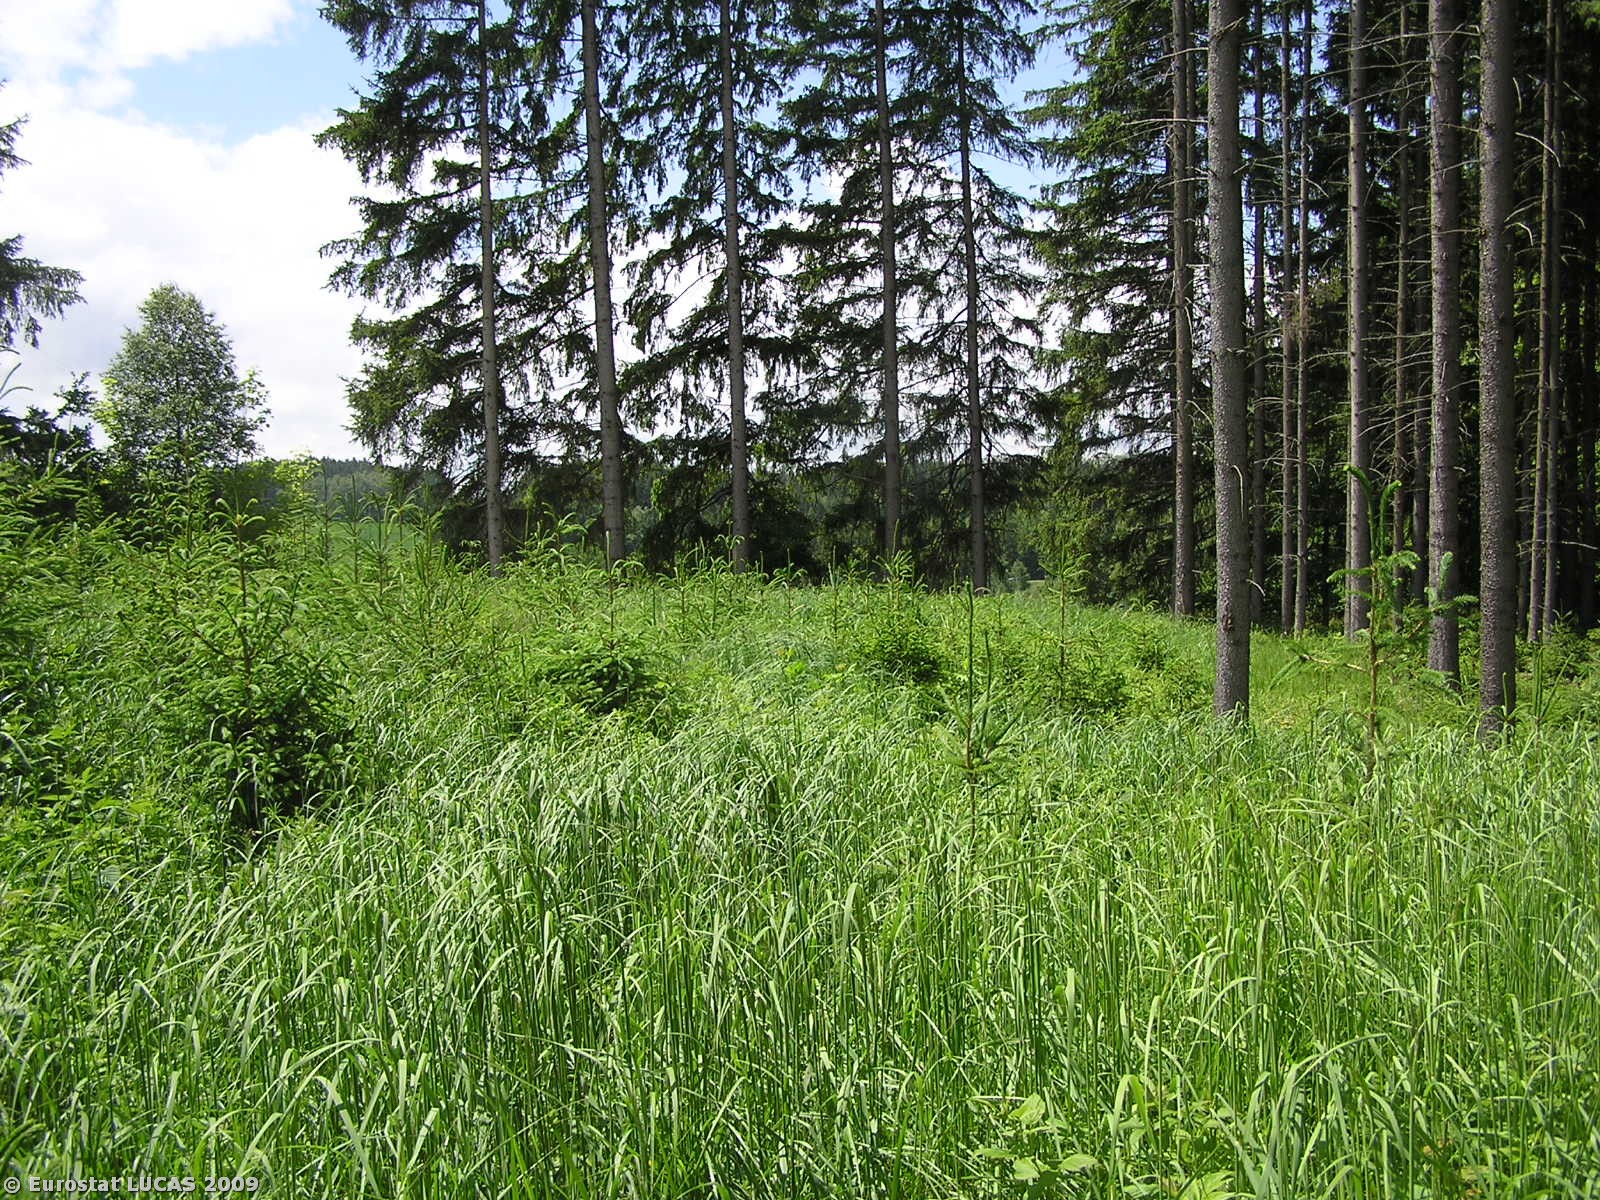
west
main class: Woodland
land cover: Coniferous woodland
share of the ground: 25 - 50 %
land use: Forestry
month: June
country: CZ
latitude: 49.4806
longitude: 14.9851
